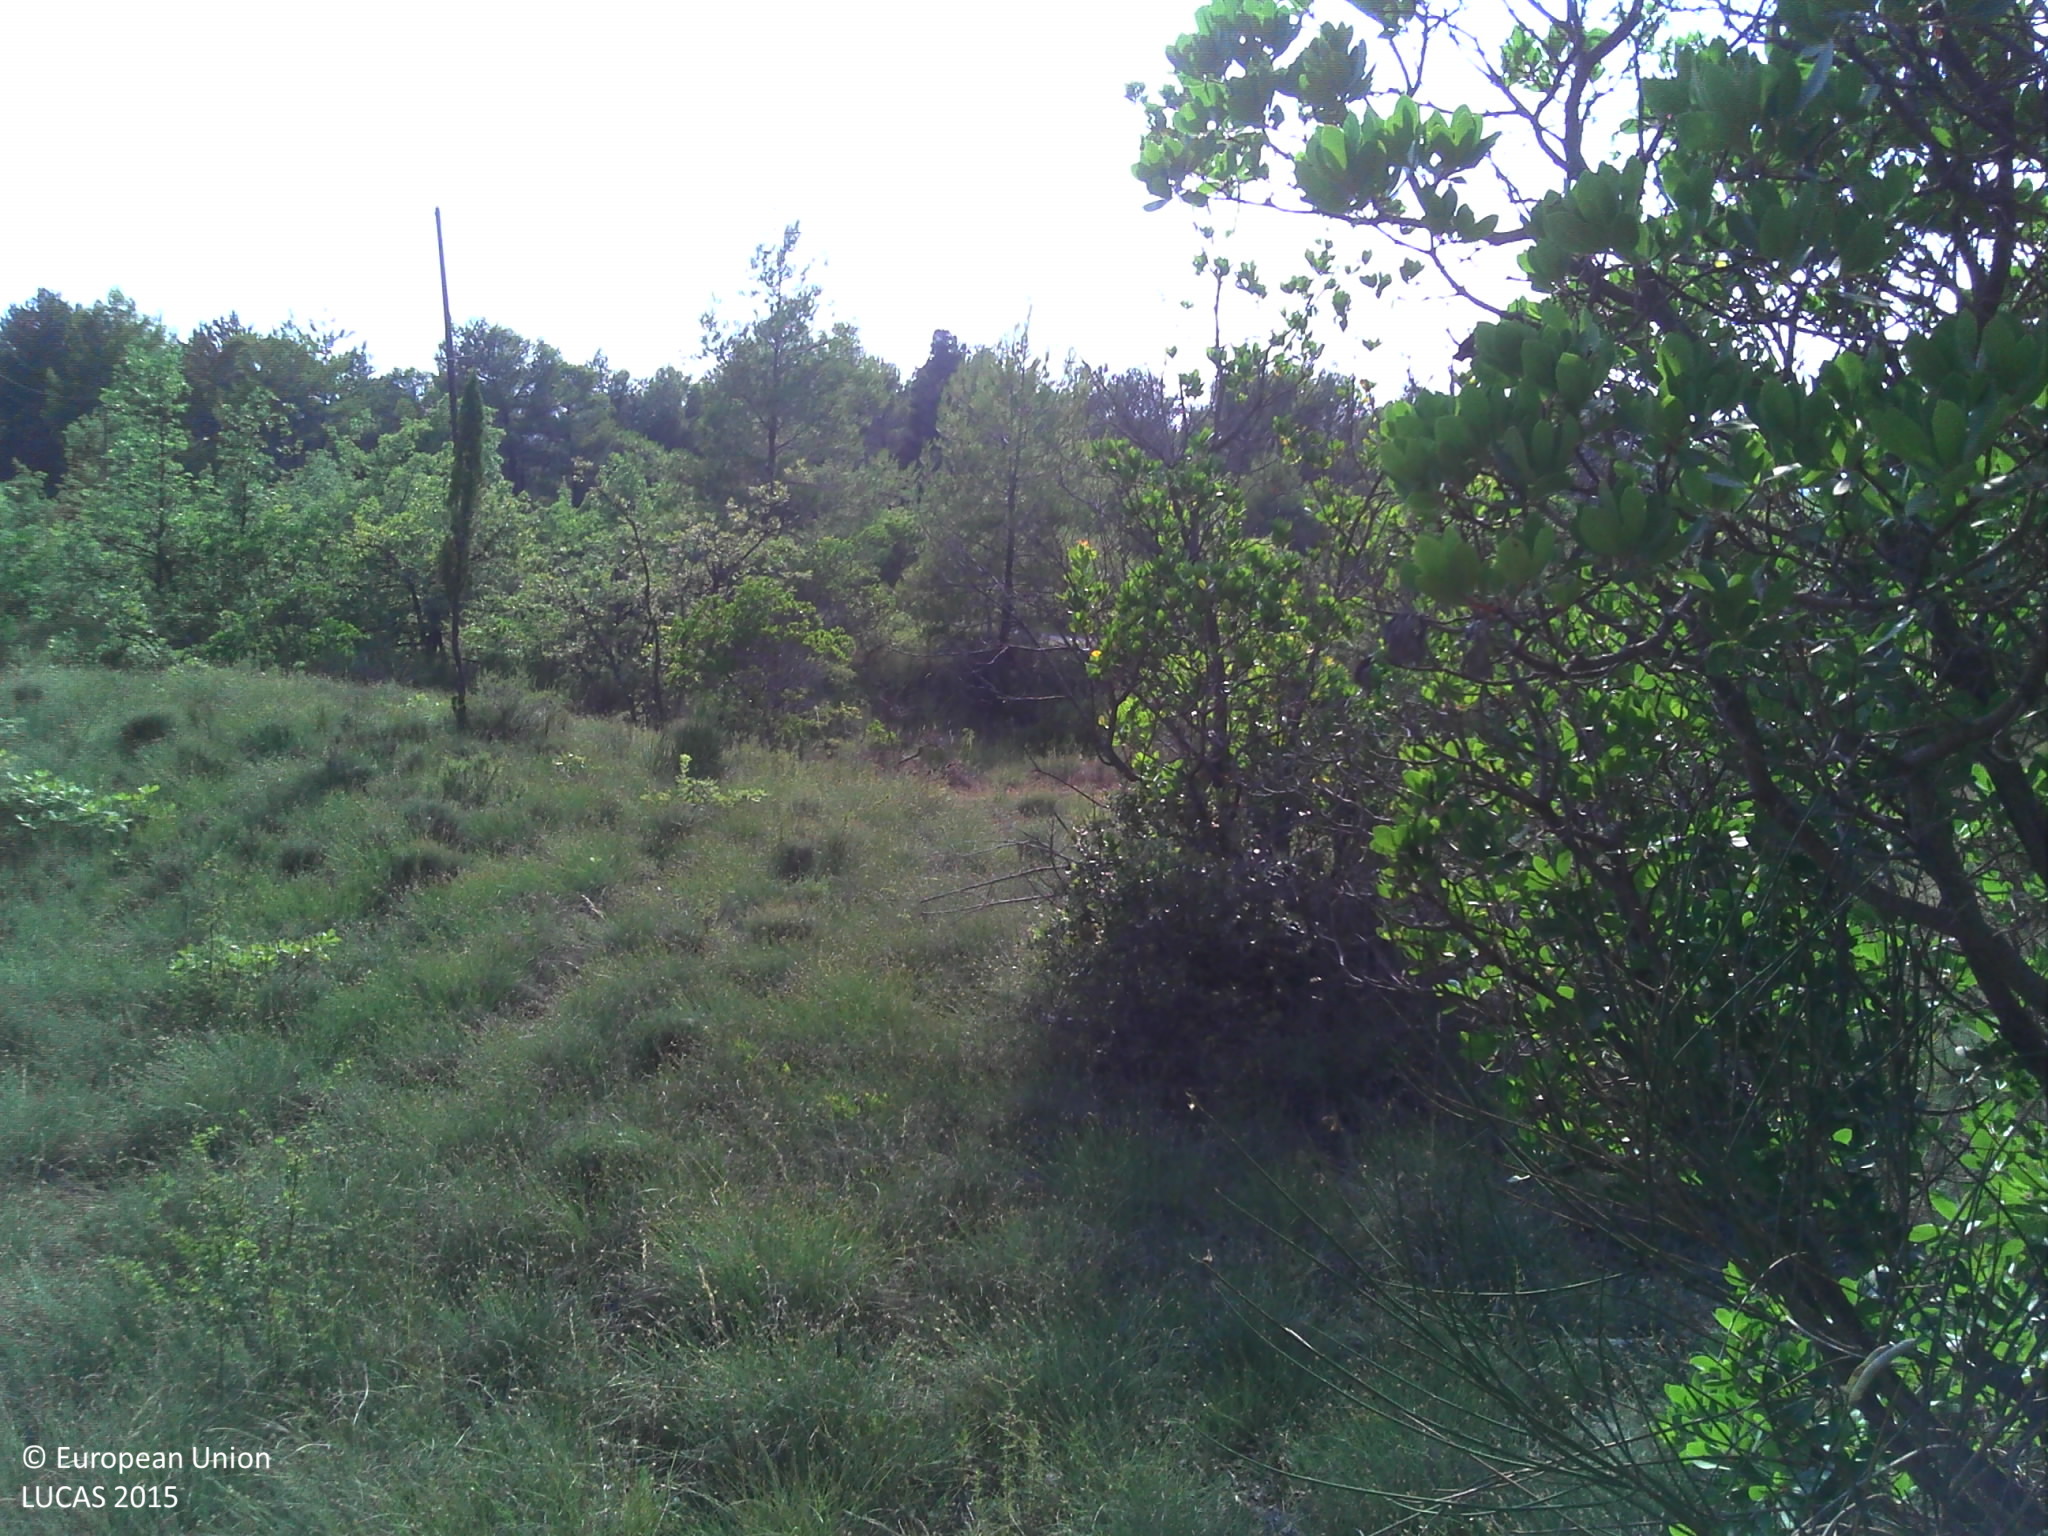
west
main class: Shrubland
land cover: Shrubland with sparse tree cover
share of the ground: > 75 %
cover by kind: shrubs 40 %, herbaceous plants 40 %, broadleaved forest trees 5 %, lichens and mosses 5 %, consolidated bare surface 5 %, unconsolidated bare surface 5 %
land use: Residential
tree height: < 5 m
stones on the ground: < 10 %
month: July
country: FR
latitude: 43.7695
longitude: 5.5987
